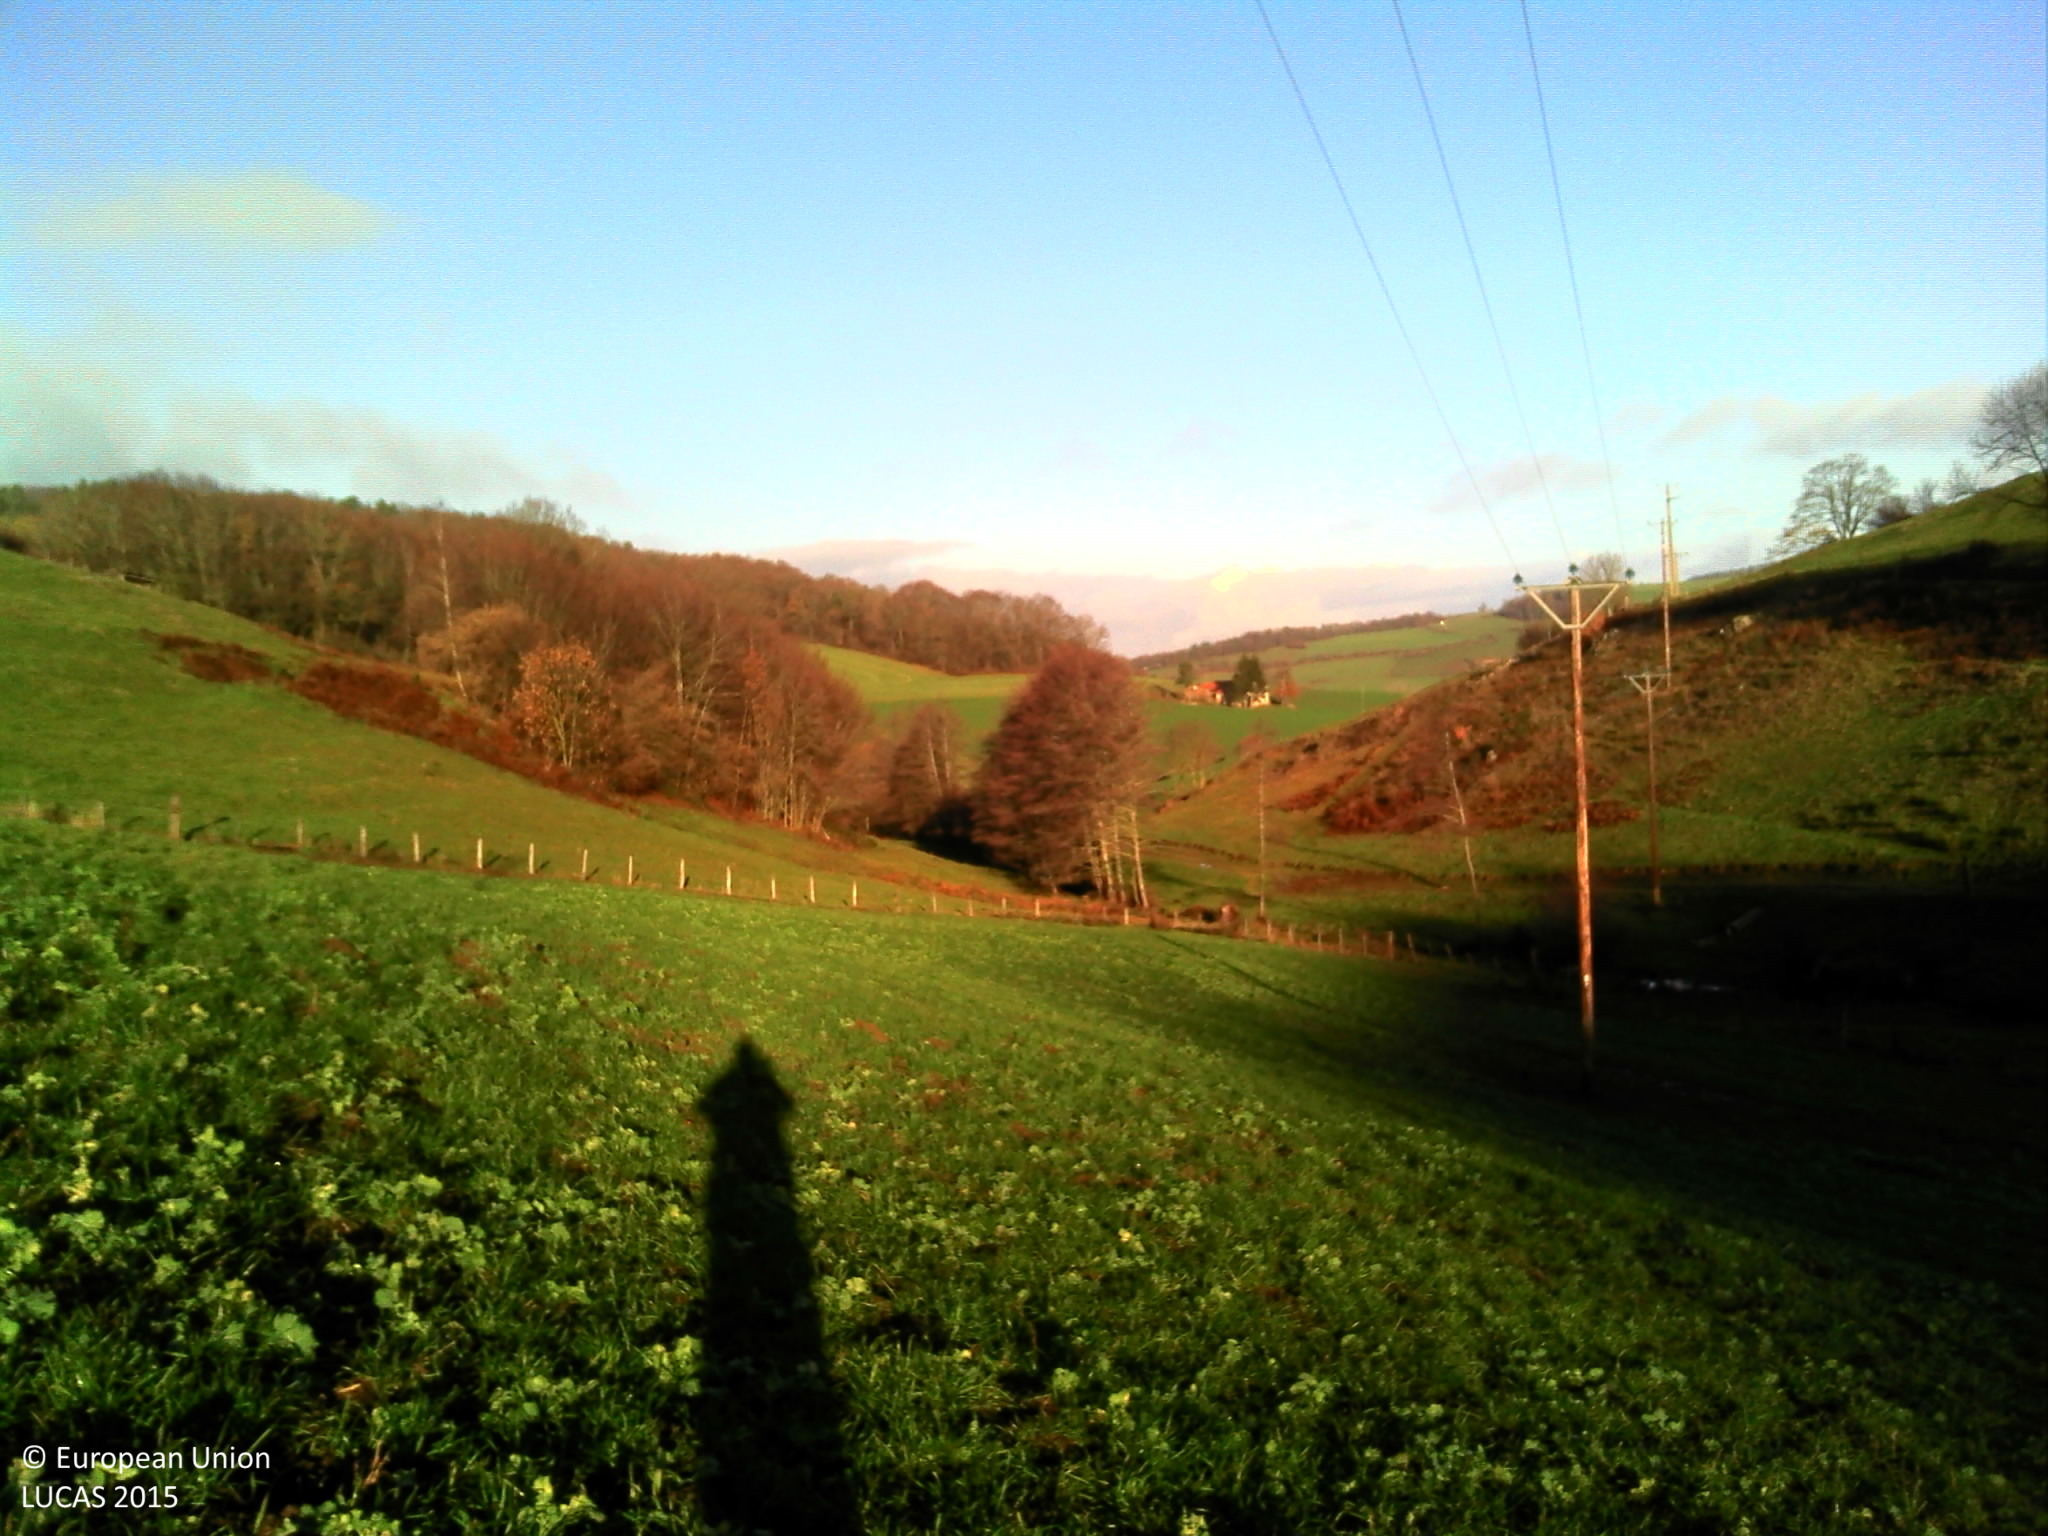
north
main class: Cropland
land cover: Rape and turnip rape
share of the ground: > 75 %
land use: Agriculture (excluding fallow land and kitchen gardens)
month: December
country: FR
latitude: 45.5588
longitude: 4.4821
